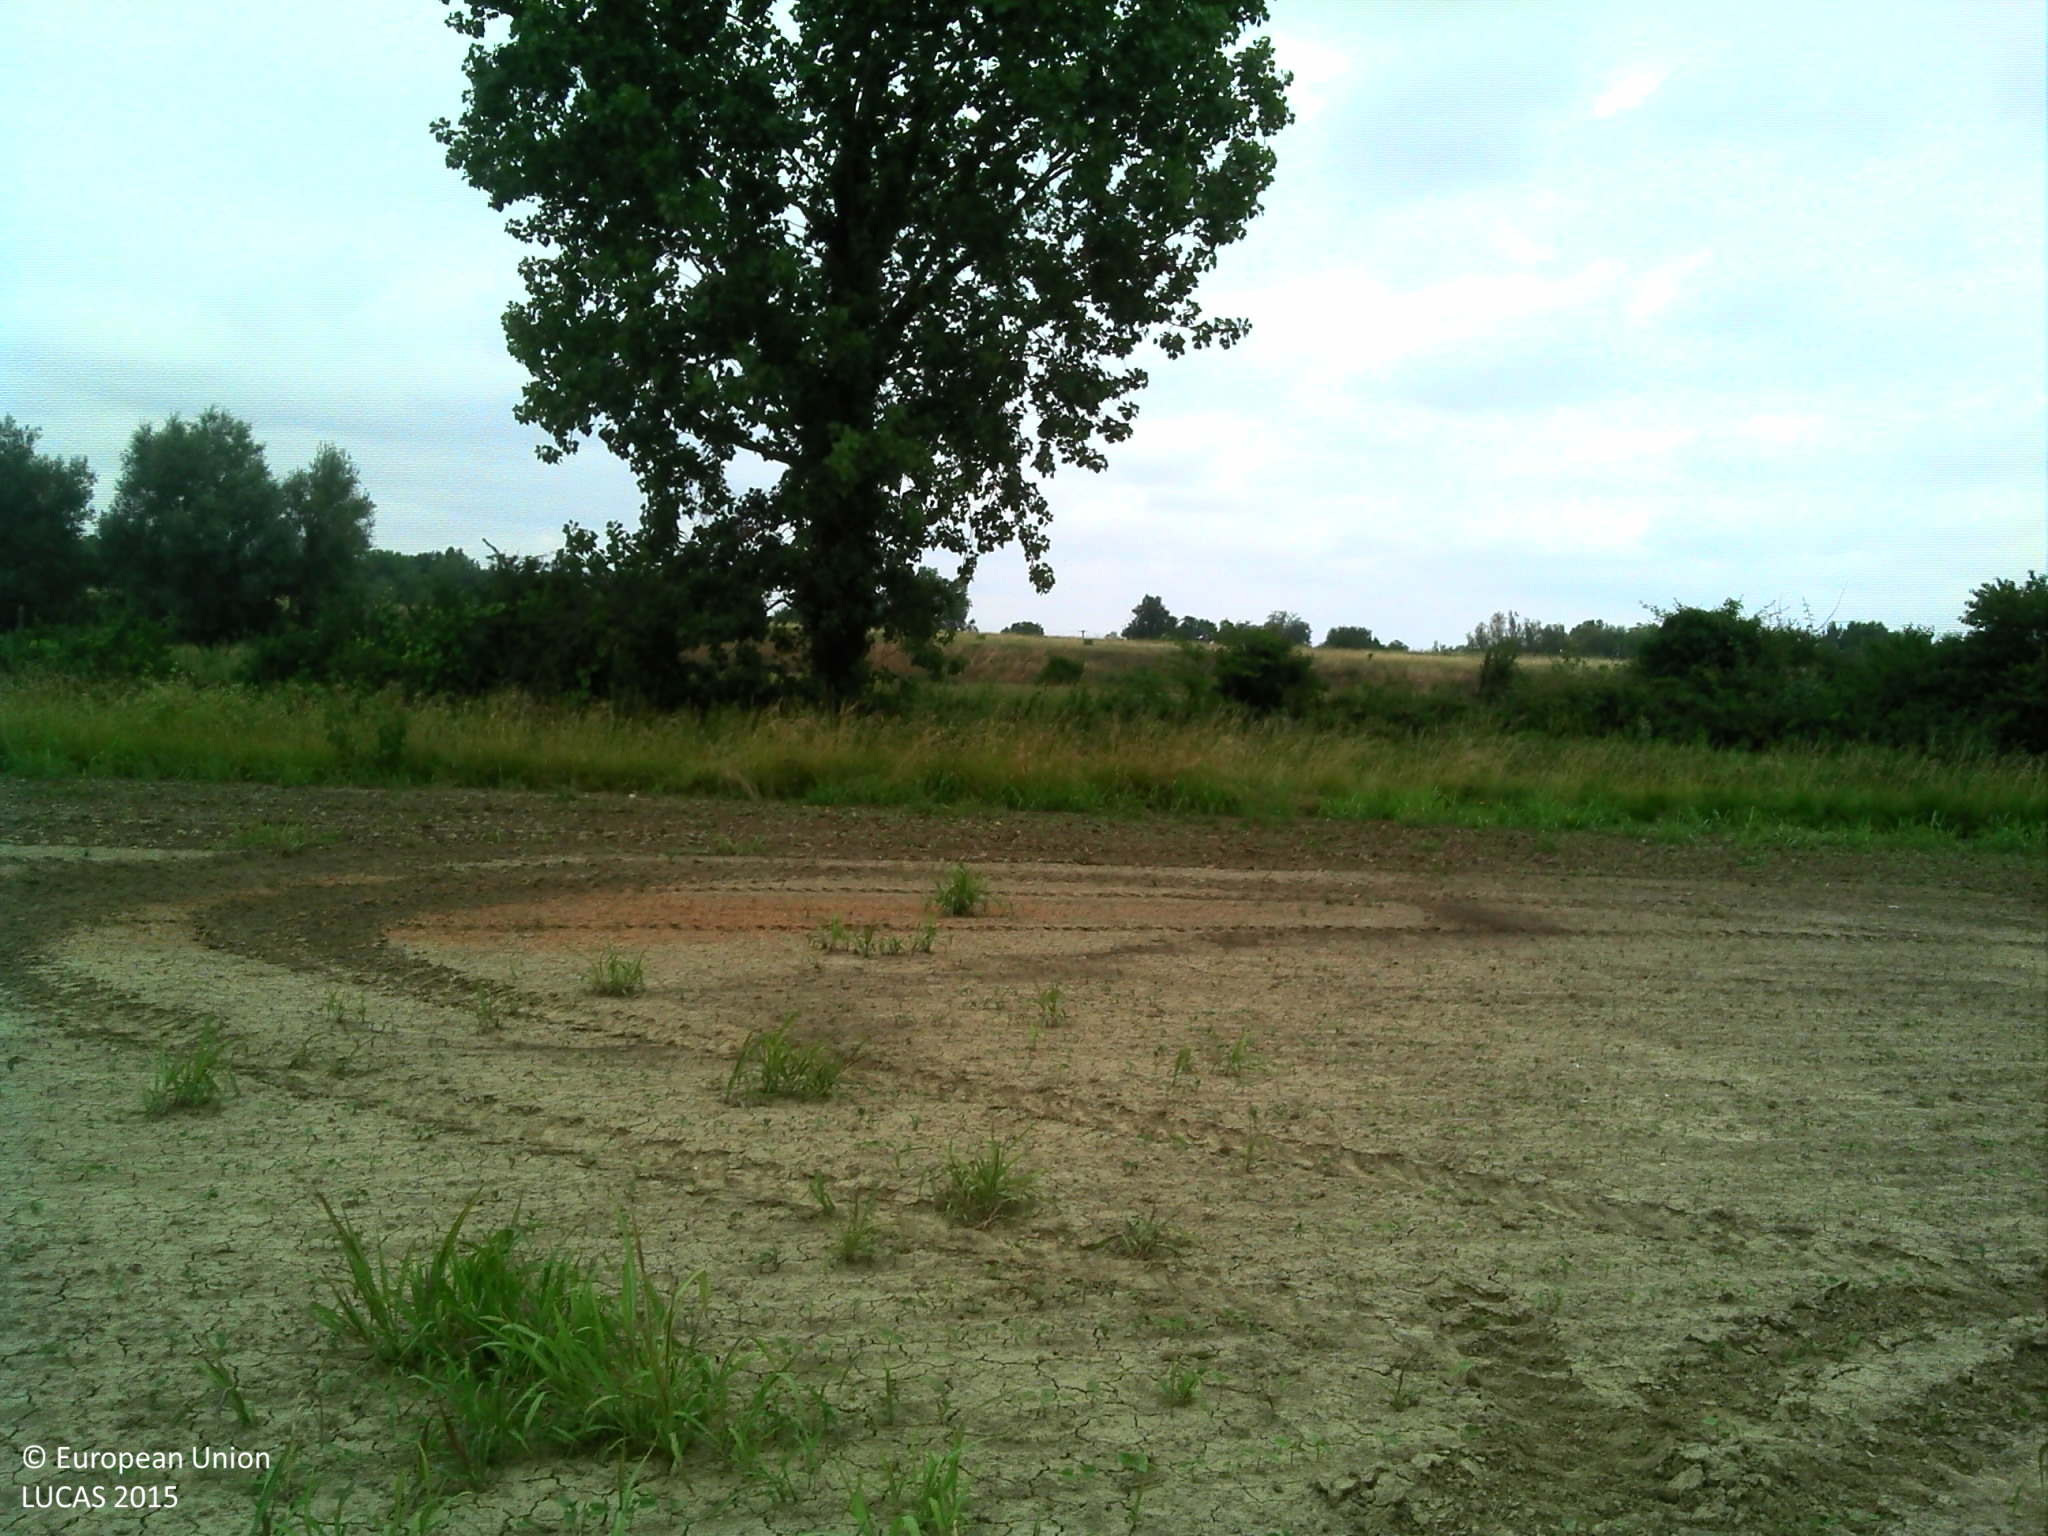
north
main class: Cropland
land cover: Other fresh vegetables
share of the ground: < 10 %
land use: Agriculture (excluding fallow land and kitchen gardens)
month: June
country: FR
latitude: 44.0966
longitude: 0.9160
